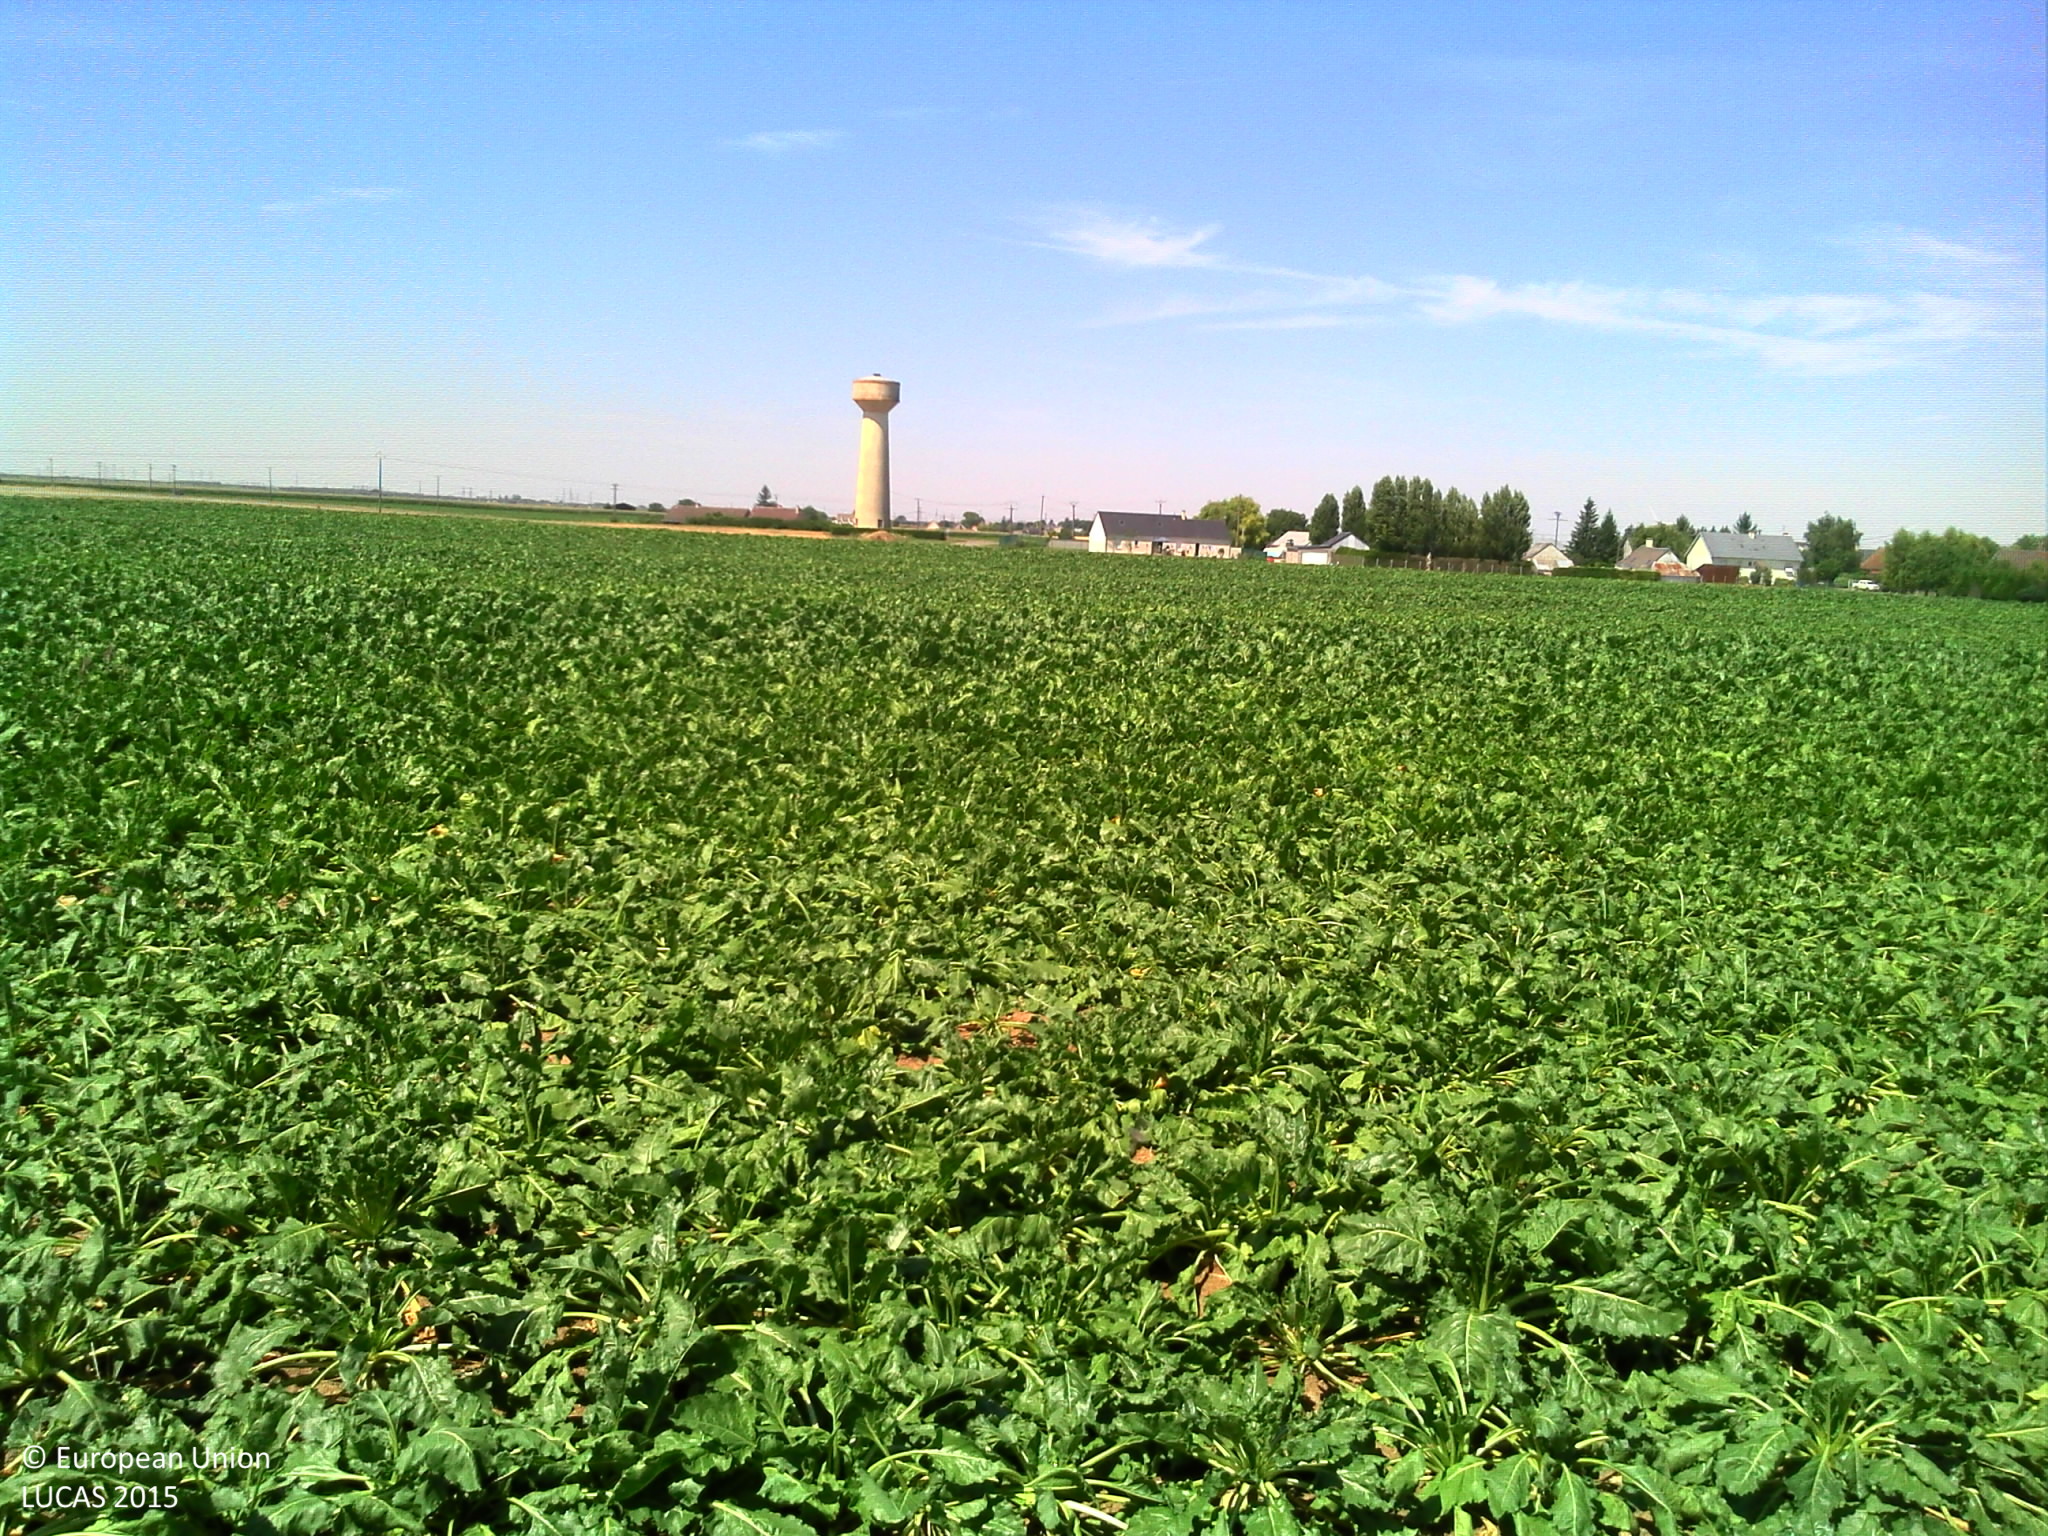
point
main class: Cropland
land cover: Sugar beet
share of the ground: > 75 %
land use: Agriculture (excluding fallow land and kitchen gardens)
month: August
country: FR
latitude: 48.1091
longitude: 1.9420
